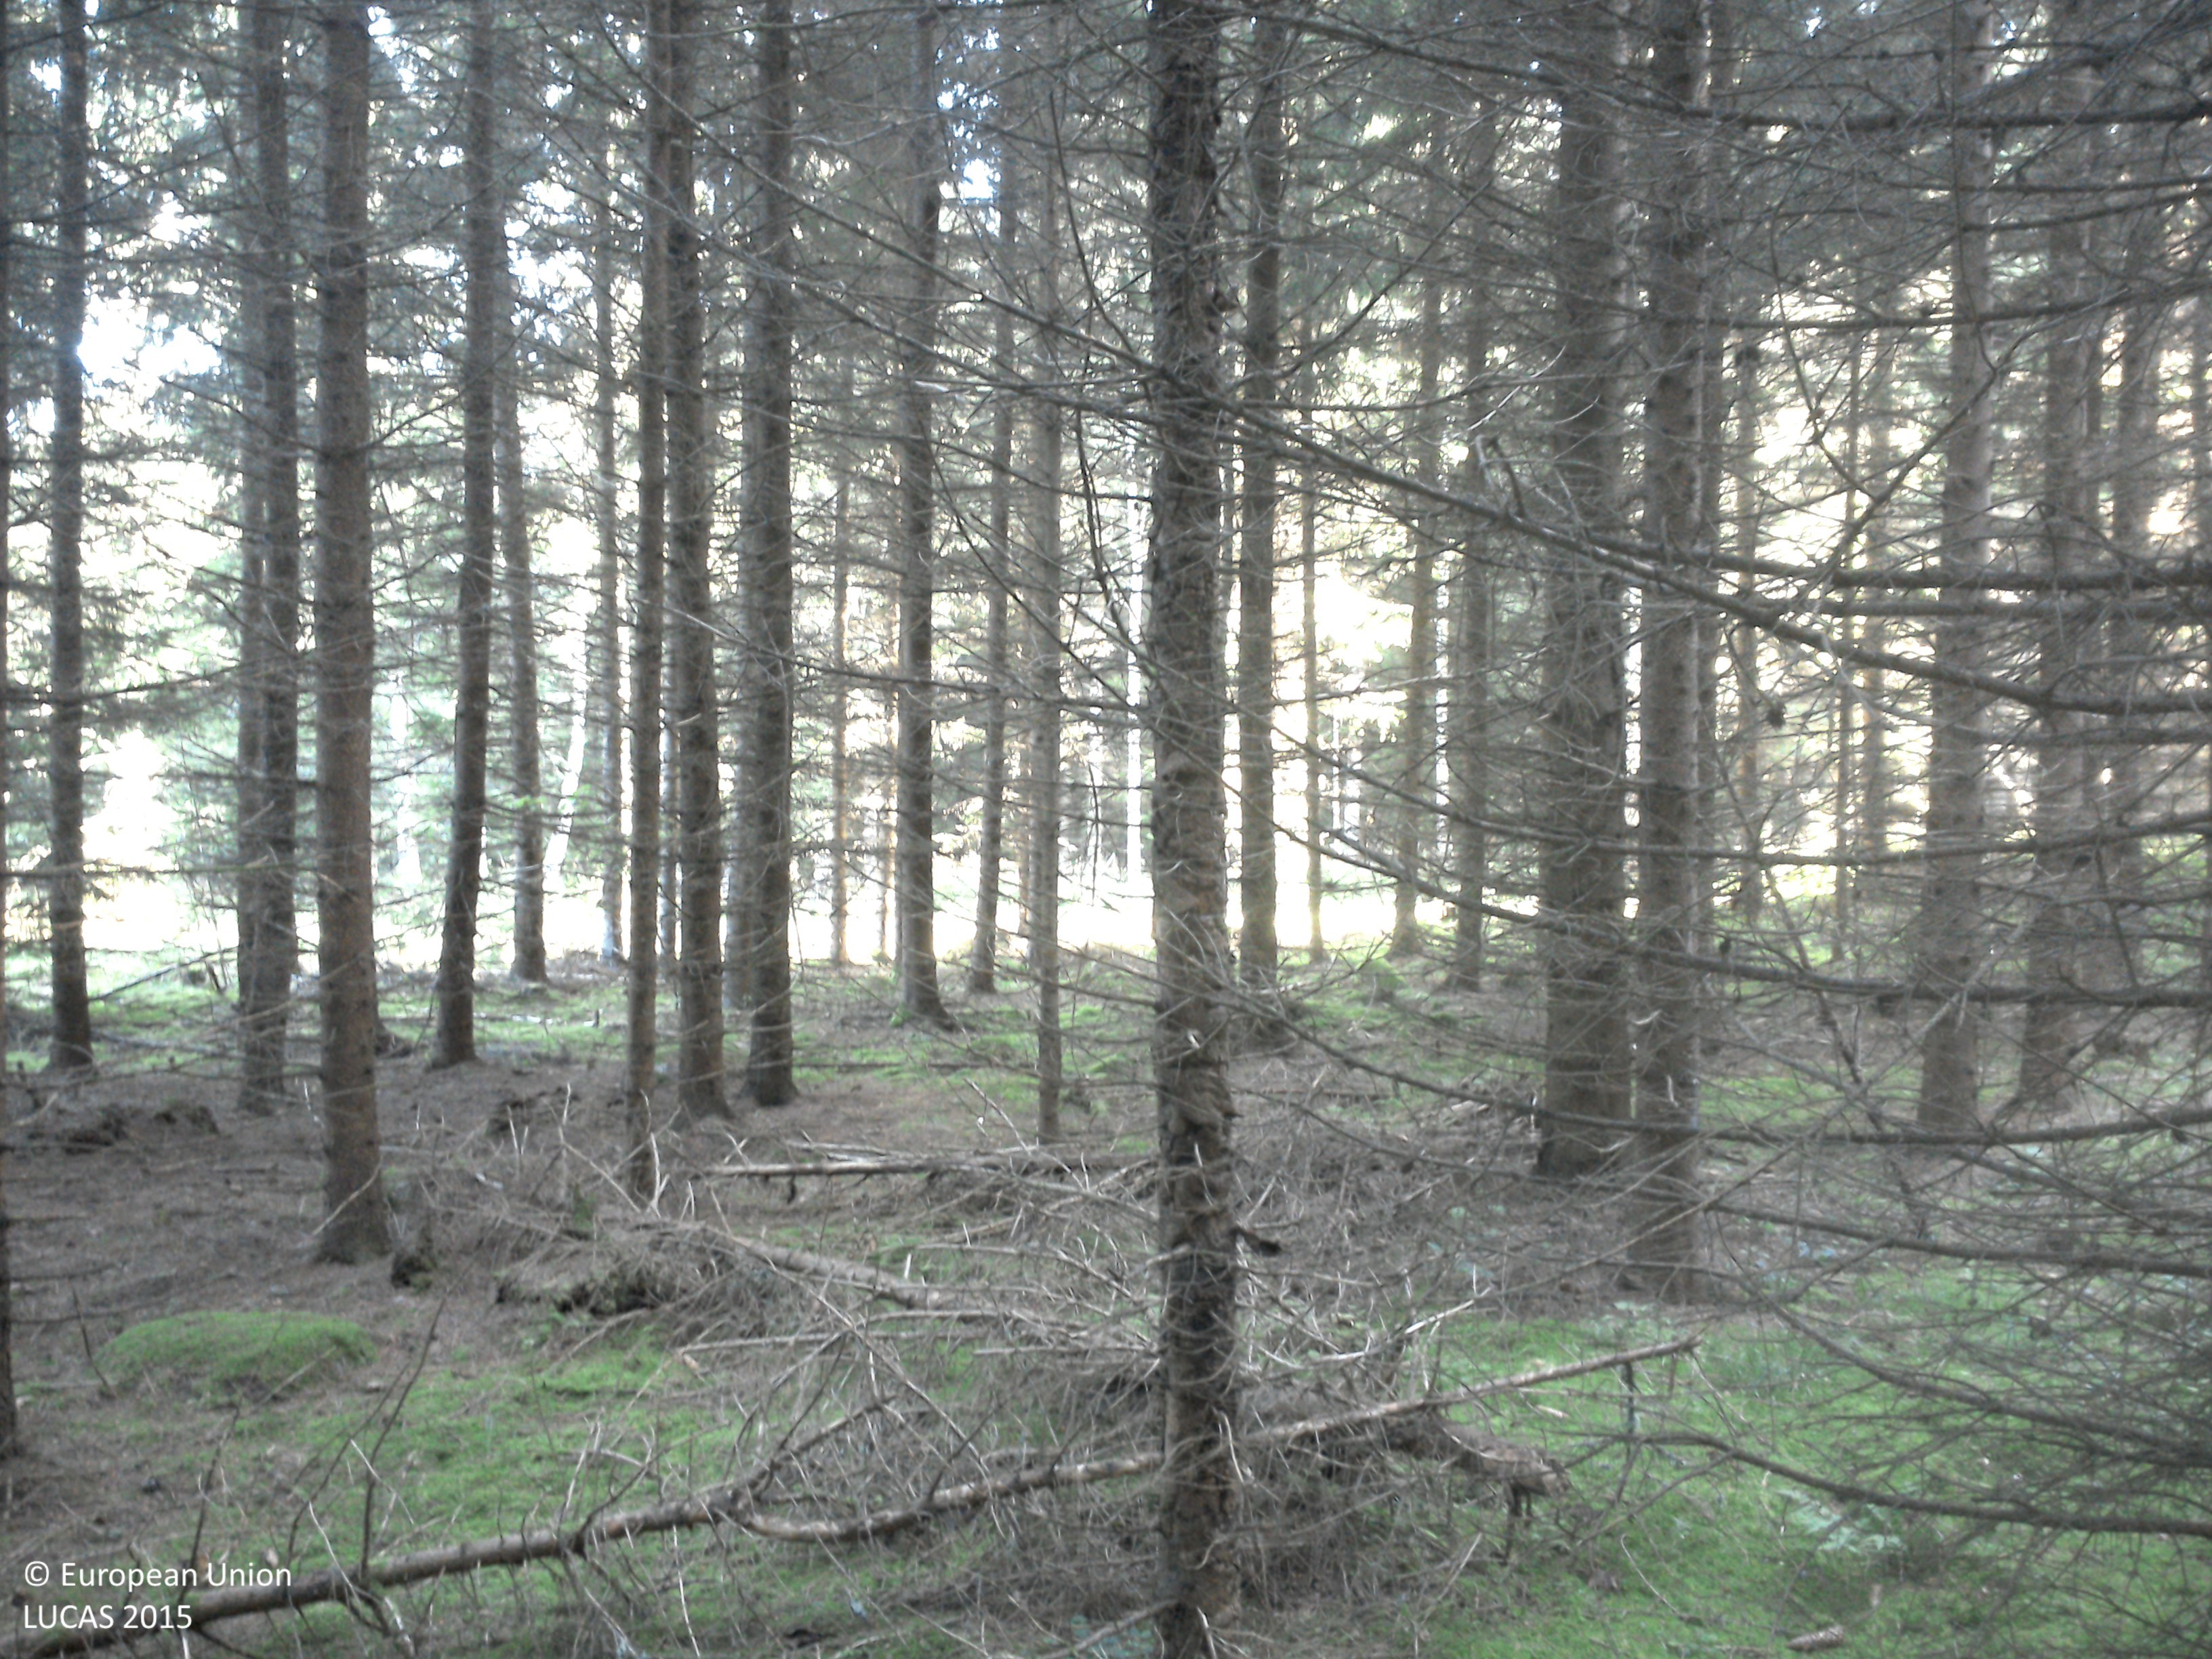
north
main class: Woodland
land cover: Spruce dominated coniferous woodland
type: boreal forest
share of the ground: > 75 %
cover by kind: coniferous forest trees 90 %, lichens and mosses 5 %, unconsolidated bare surface 5 %
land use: Forestry
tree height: > 5 m
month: August
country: SE
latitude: 57.9727
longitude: 15.2531
